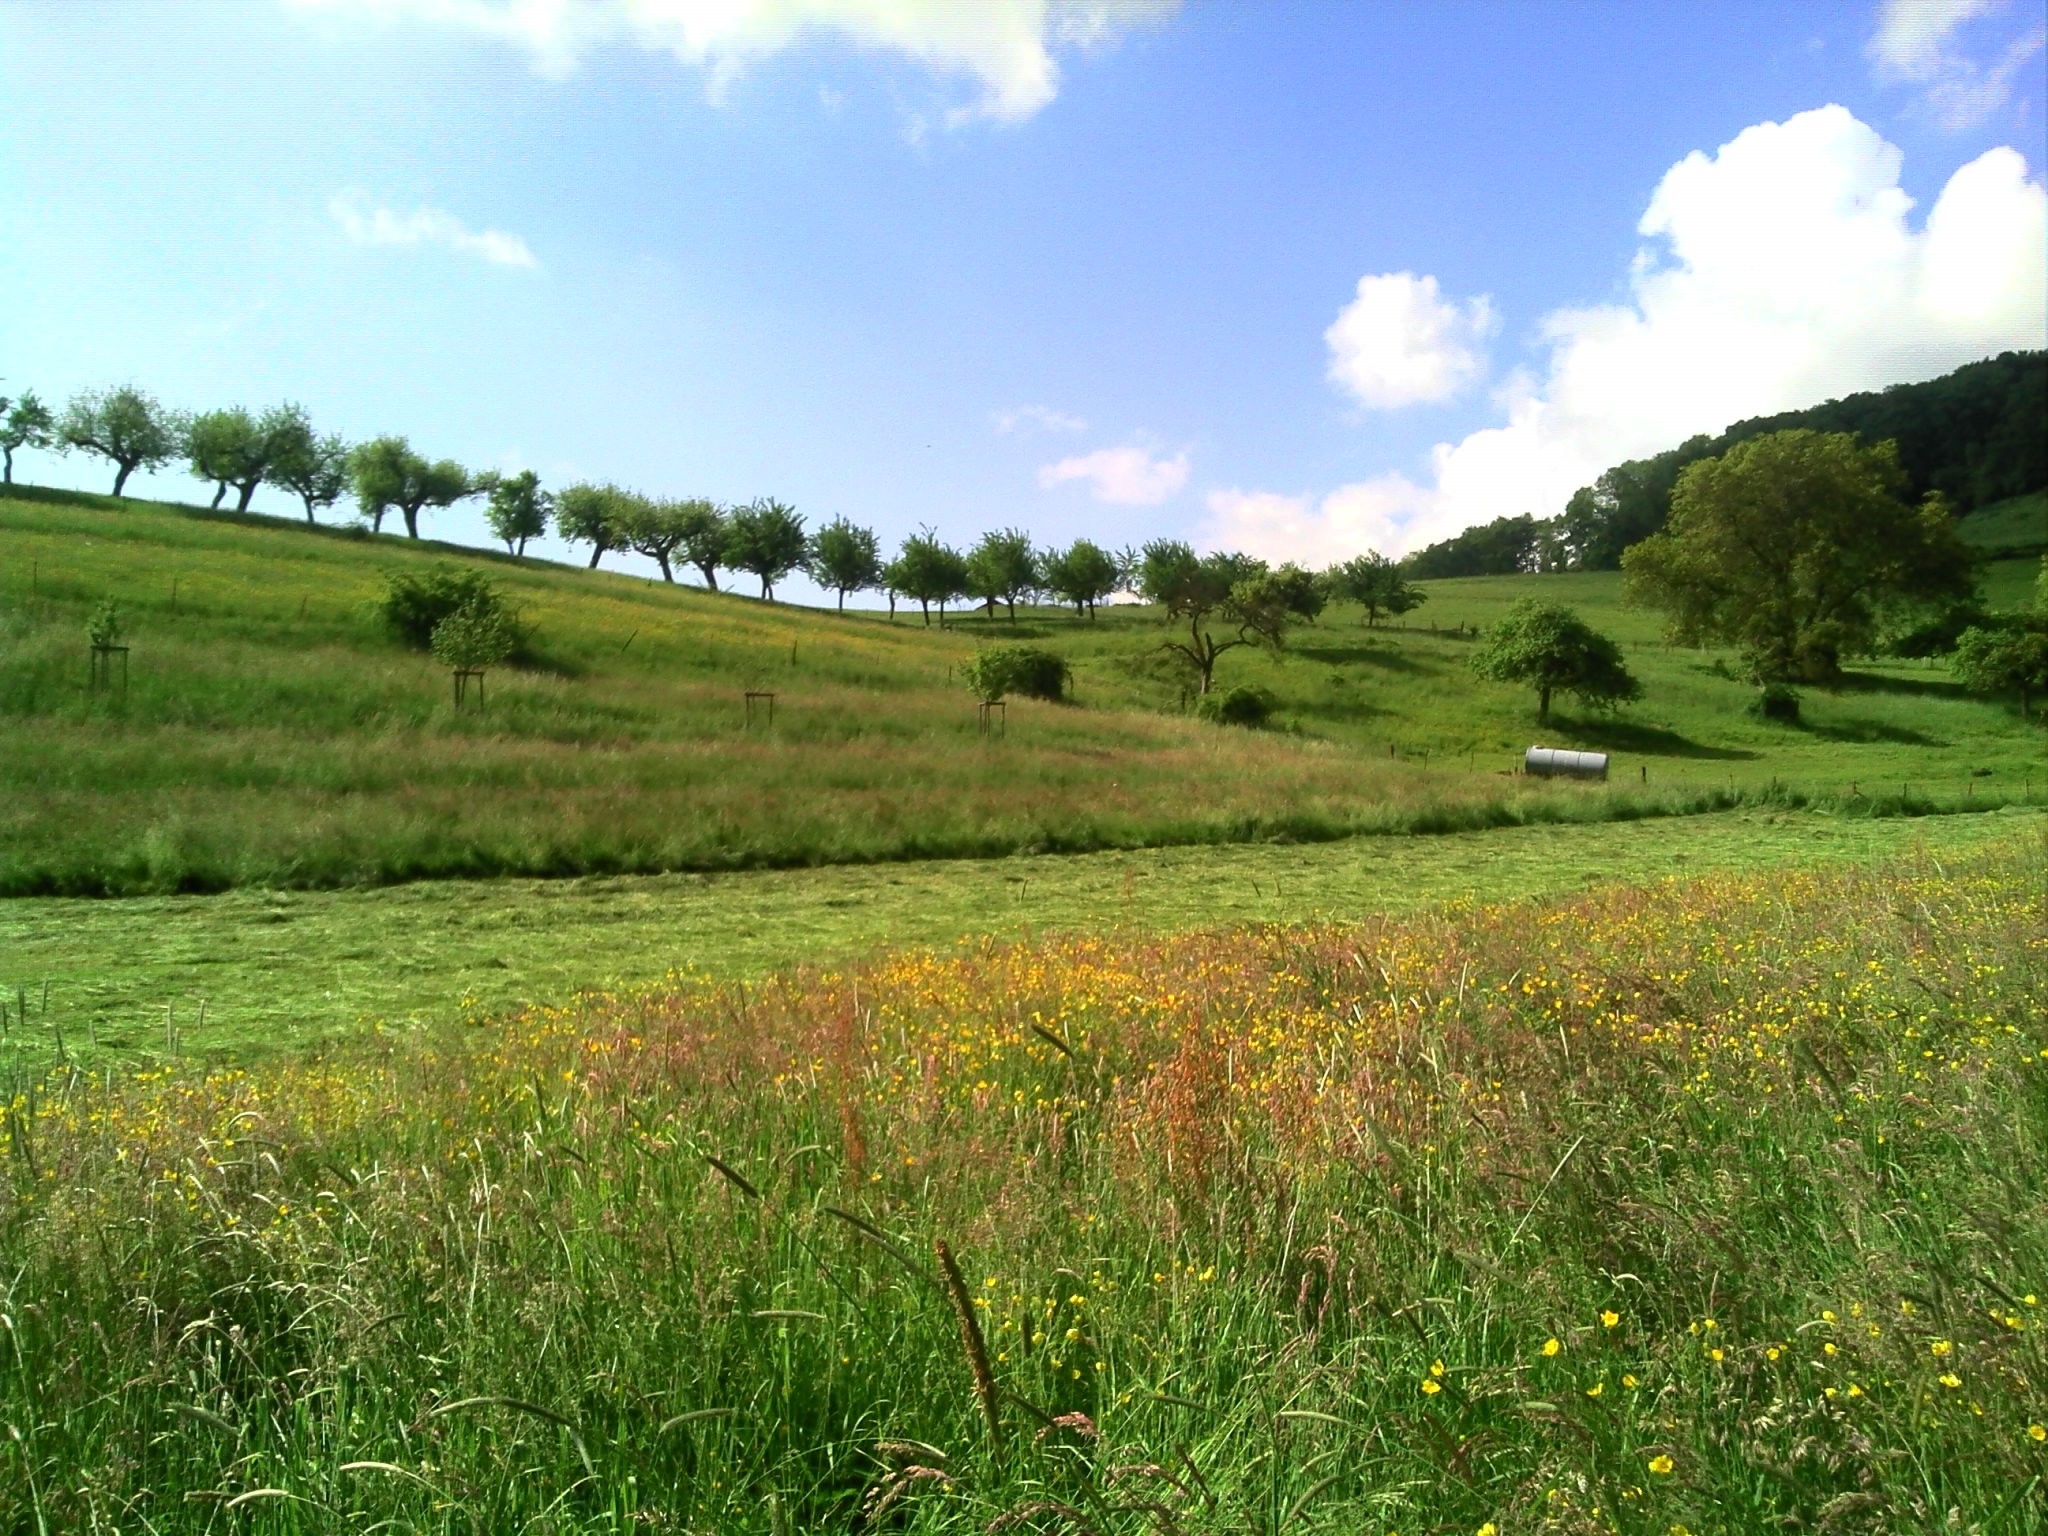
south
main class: Grassland
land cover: Grassland without tree/shrub cover
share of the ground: > 75 %
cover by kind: herbaceous plants 100 %
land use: Agriculture (excluding fallow land and kitchen gardens)
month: May
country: LU
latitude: 49.5655
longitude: 6.2803
